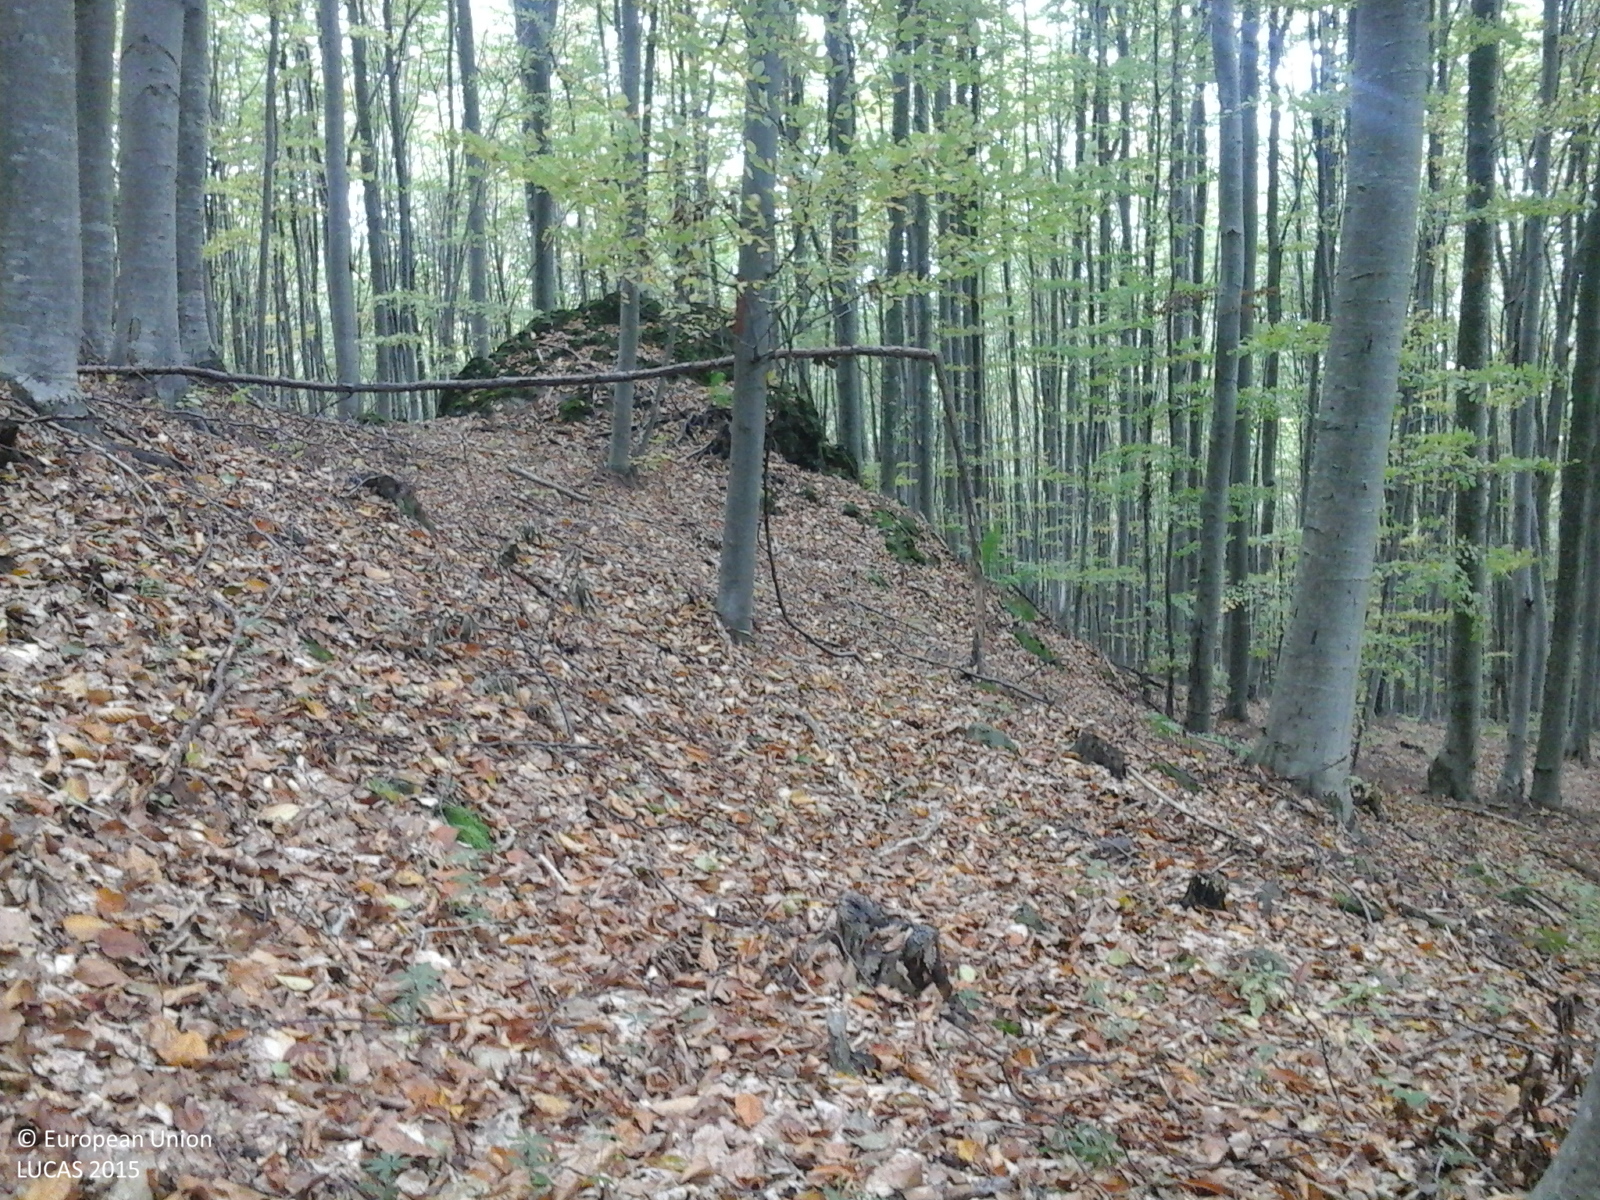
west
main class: Woodland
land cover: Broadleaved woodland
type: beech forest
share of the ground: > 75 %
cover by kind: broadleaved forest trees 100 %
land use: Forestry
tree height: > 5 m
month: October
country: RO
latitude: 46.6436
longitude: 24.9786
